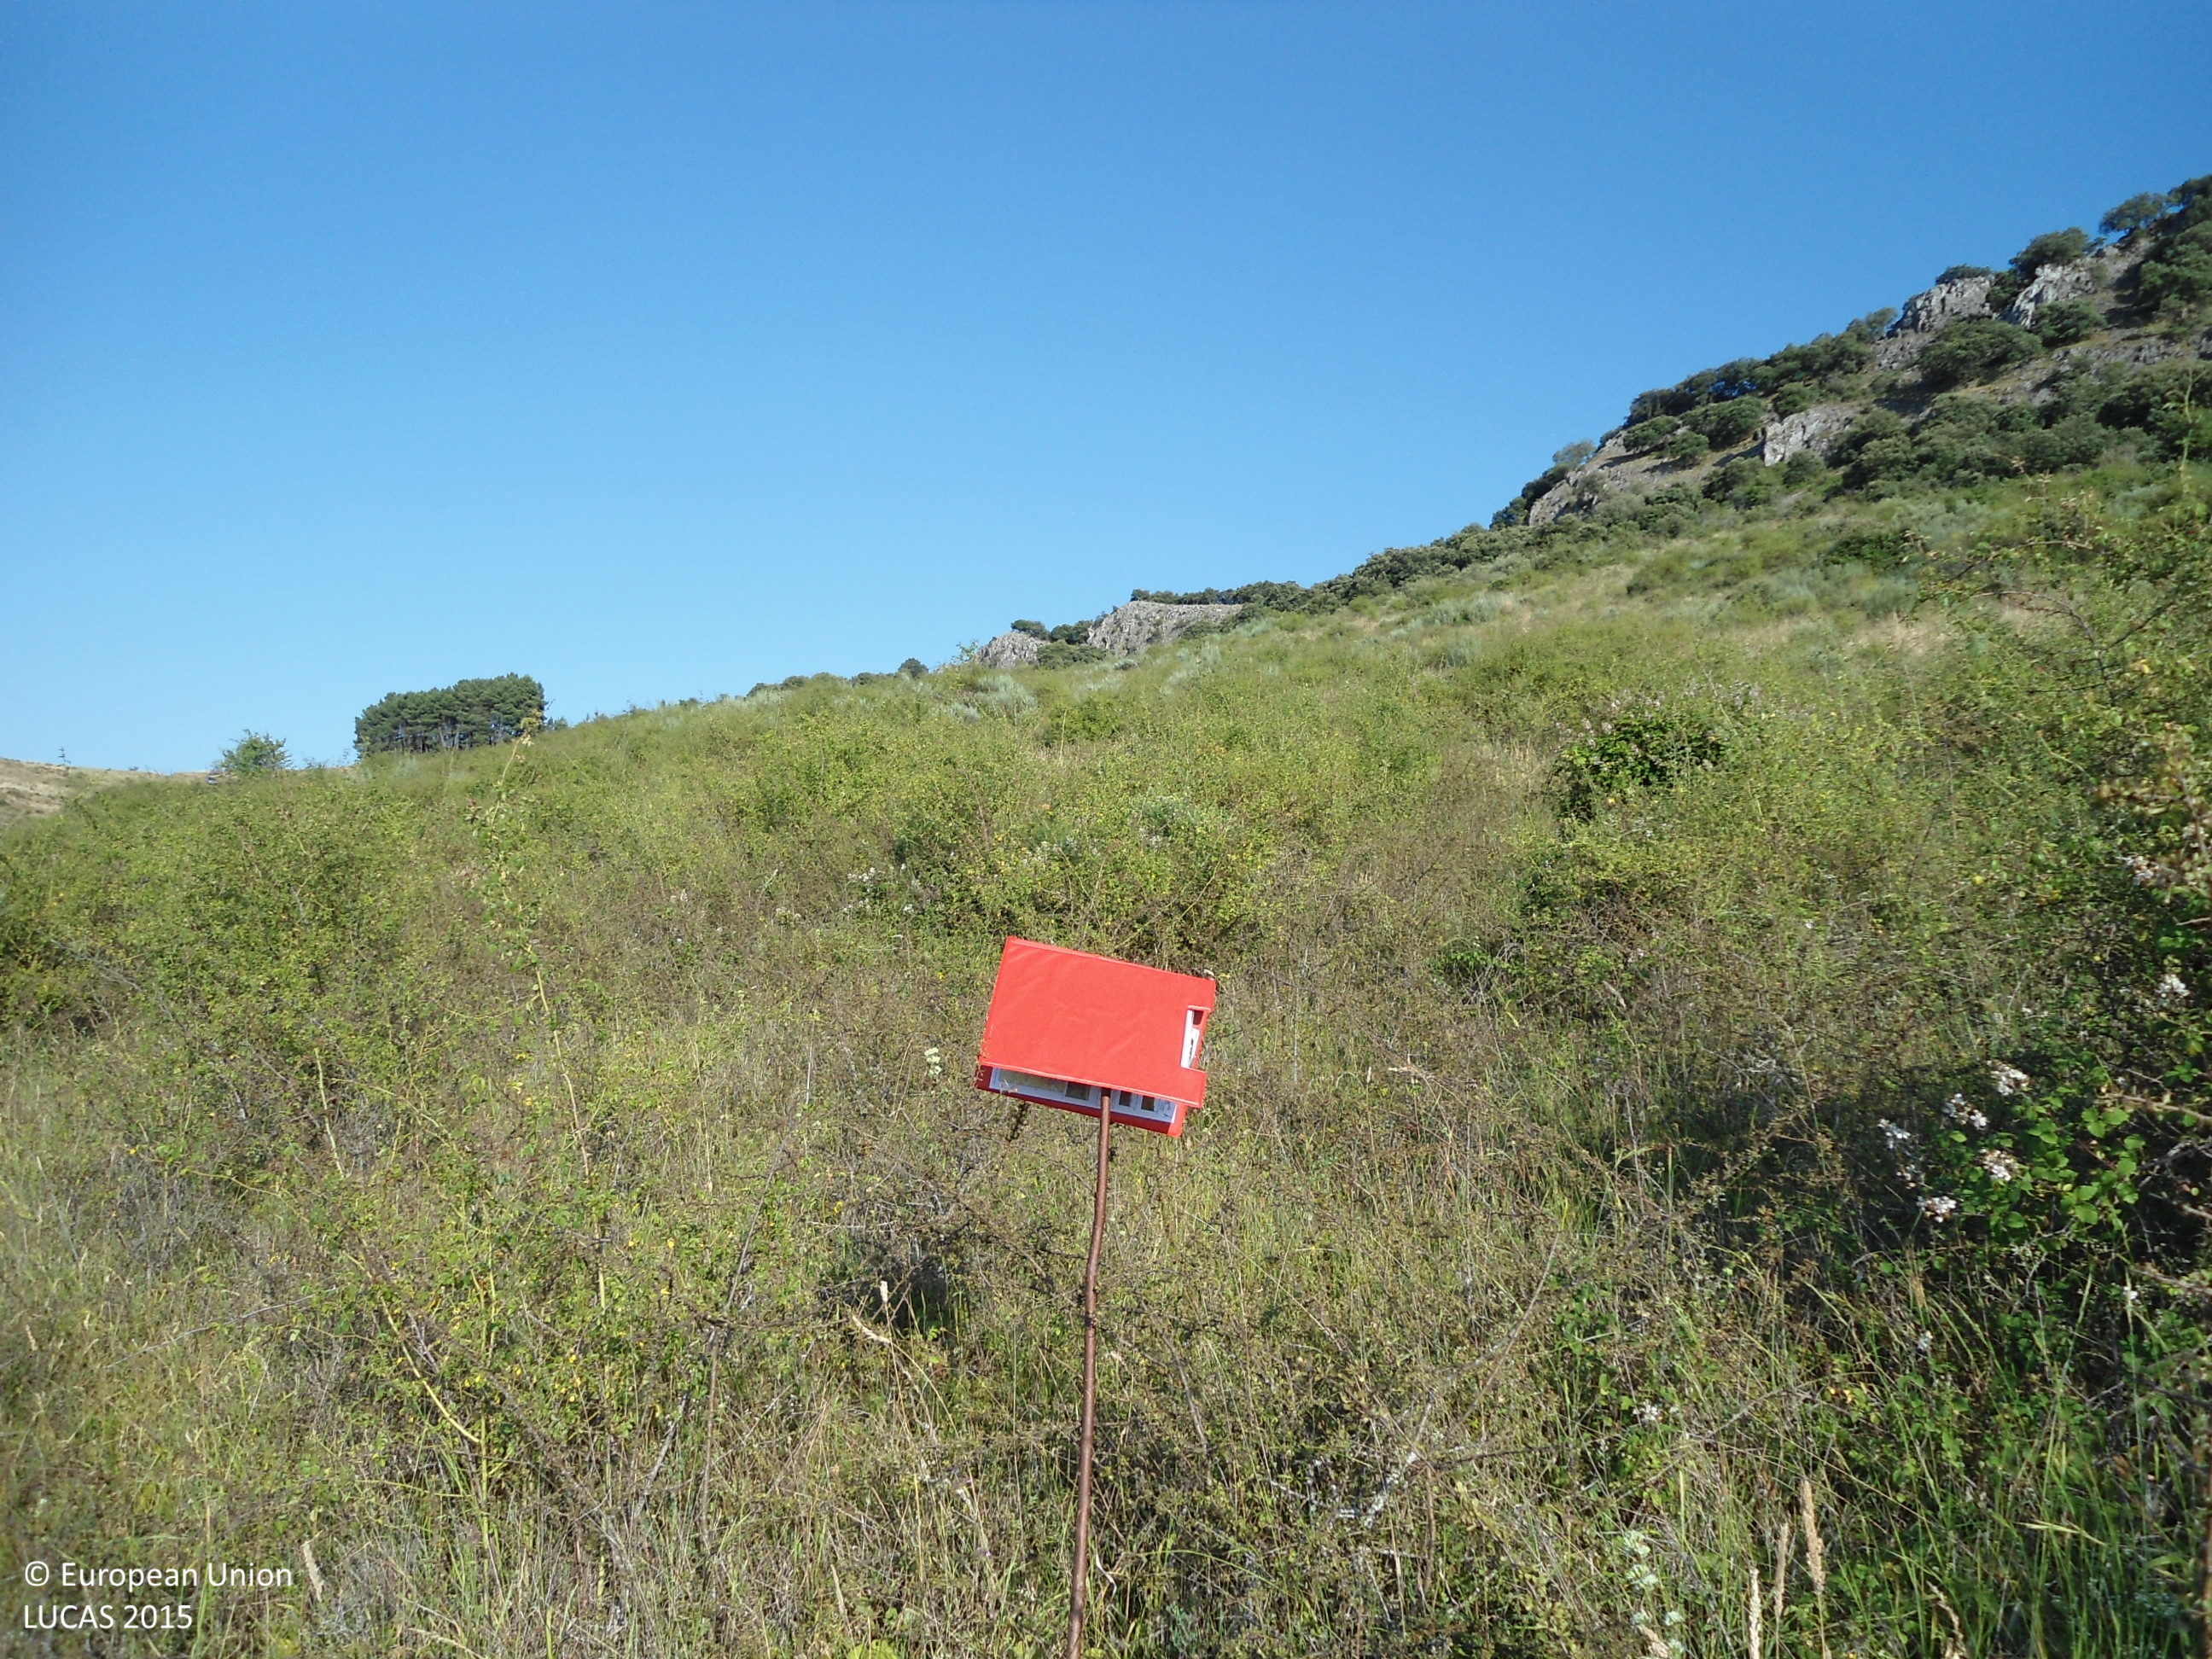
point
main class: Shrubland
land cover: Shrubland without tree cover
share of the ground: > 75 %
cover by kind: shrubs 85 %, herbaceous plants 15 %
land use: Semi-natural and natural areas not in use
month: June
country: ES
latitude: 42.4642
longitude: -6.8468
